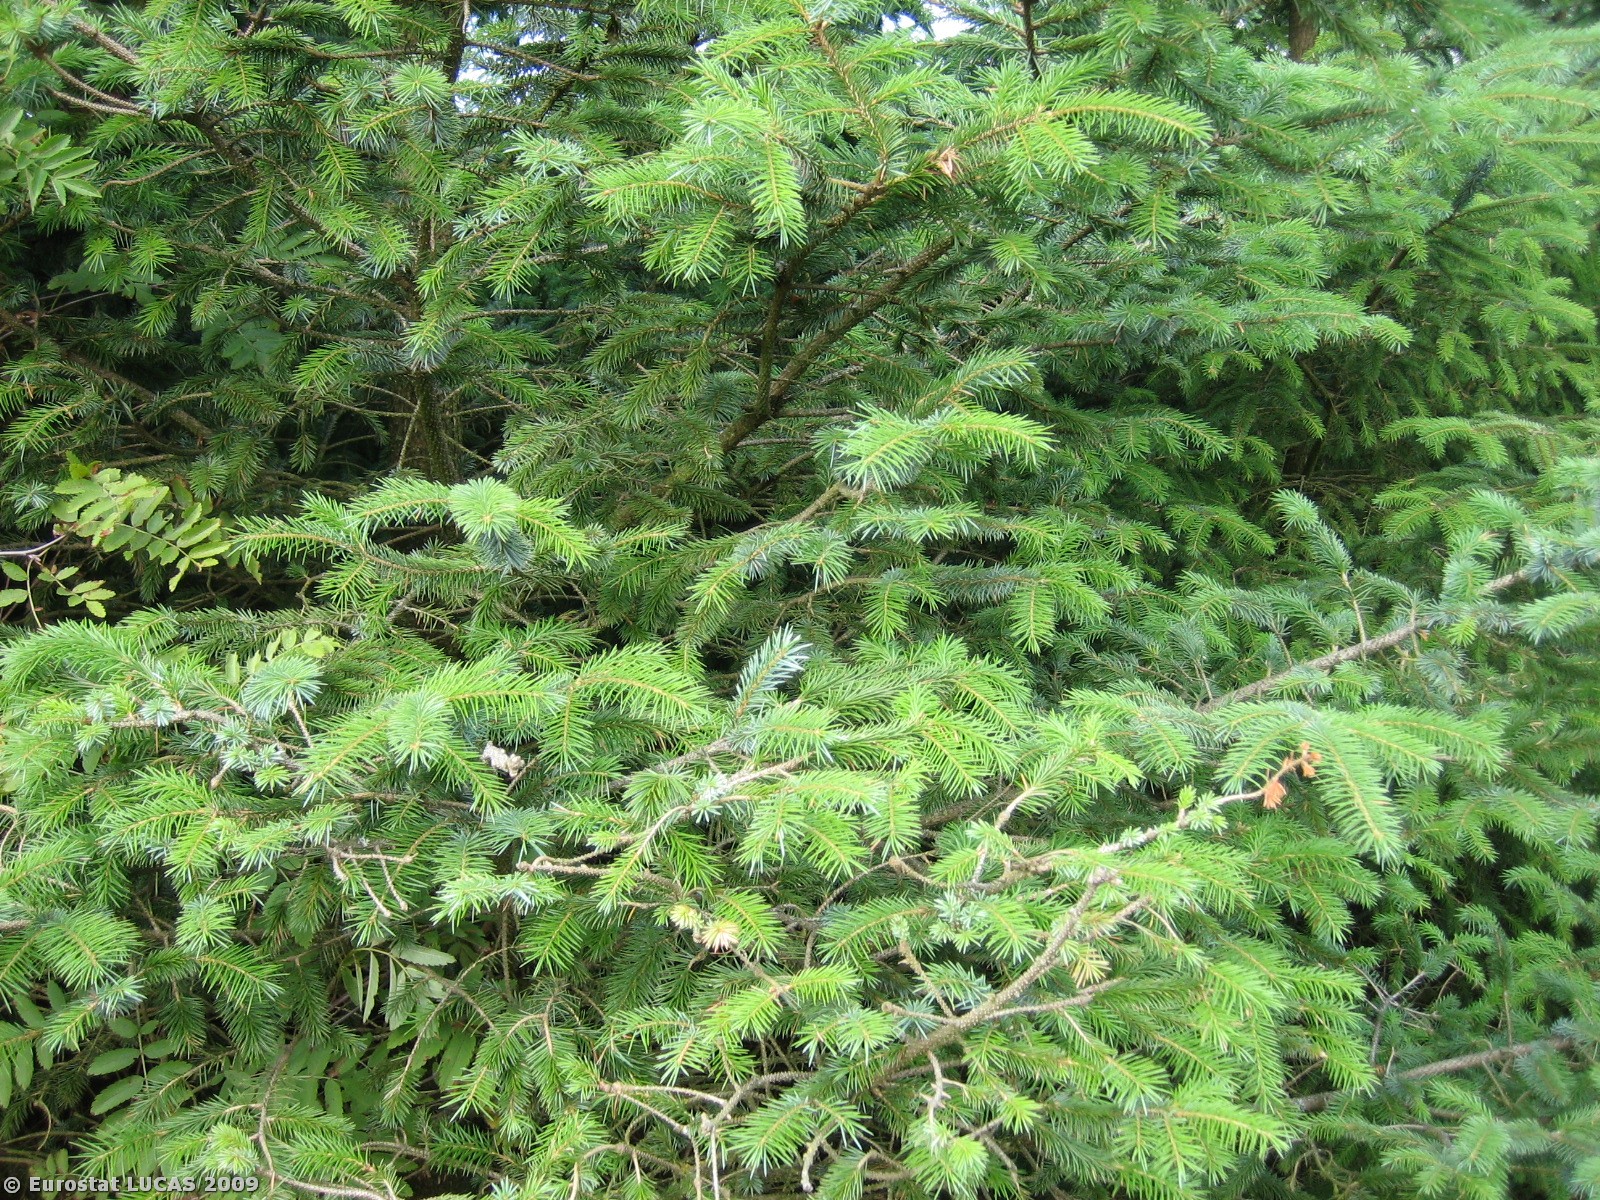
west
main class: Woodland
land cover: Coniferous woodland
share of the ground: > 75 %
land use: Forestry
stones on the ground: < 10 %
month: July
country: DK
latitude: 55.5653
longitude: 8.3048
